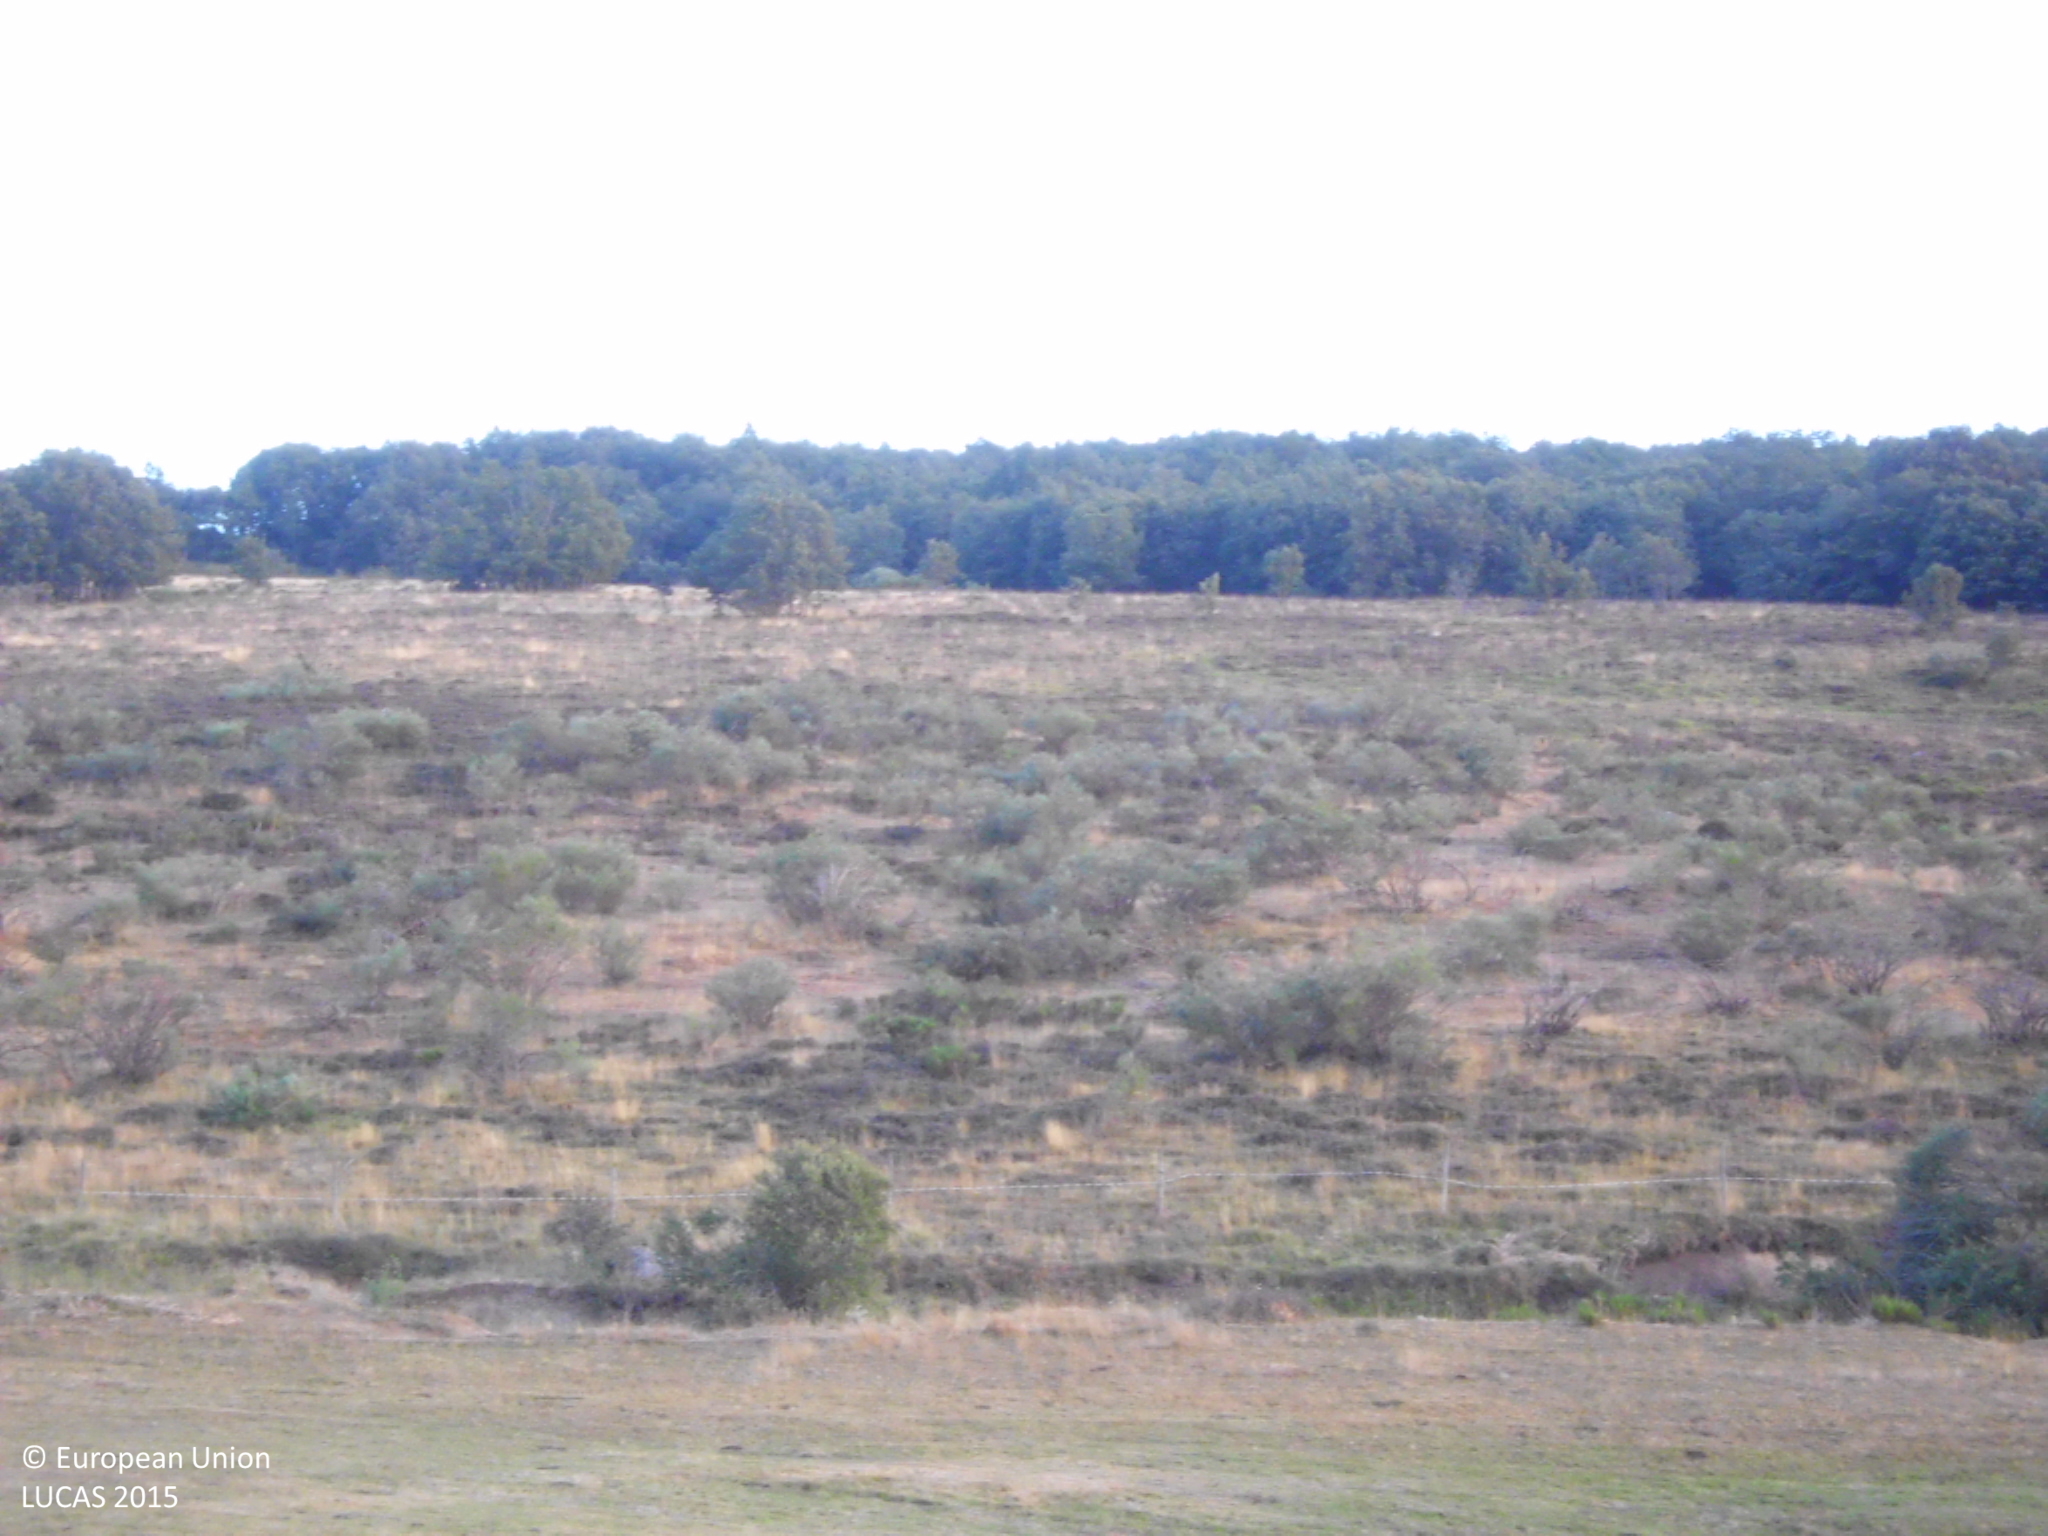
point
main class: Grassland
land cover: Grassland without tree/shrub cover
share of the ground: > 75 %
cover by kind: herbaceous plants 100 %
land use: Agriculture (excluding fallow land and kitchen gardens)
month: July
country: ES
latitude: 42.9334
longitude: -4.4278
